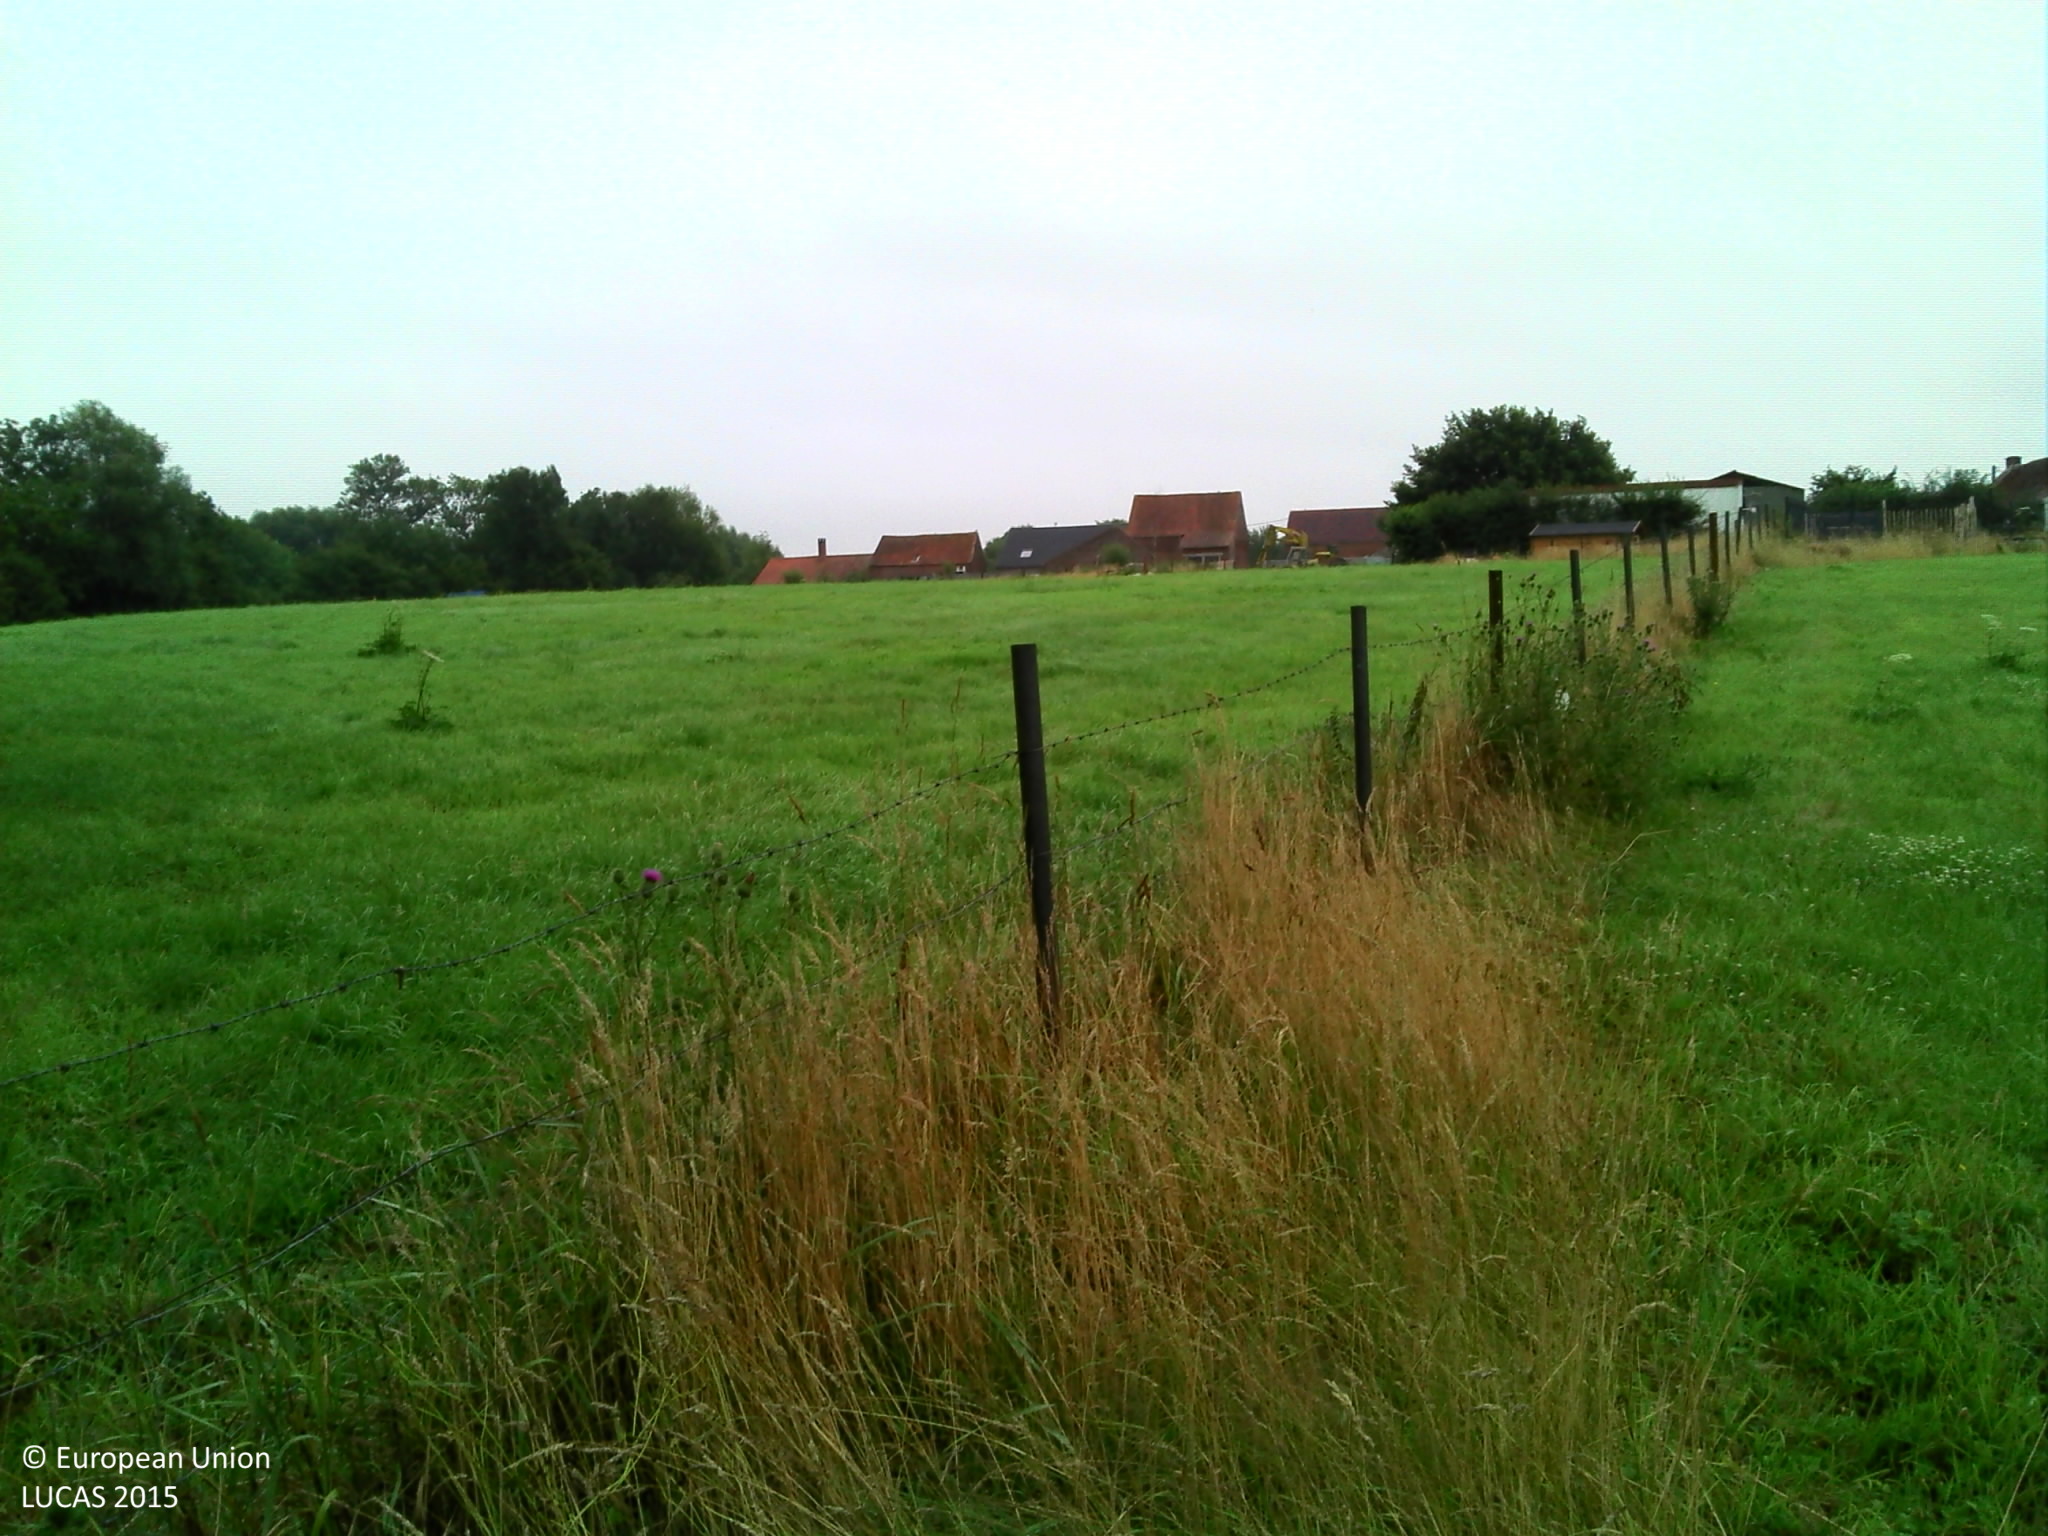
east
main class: Grassland
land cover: Grassland without tree/shrub cover
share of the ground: > 75 %
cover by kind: herbaceous plants 100 %
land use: Agriculture (excluding fallow land and kitchen gardens)
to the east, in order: Grassland without tree/shrub cover; Fences; Grassland without tree/shrub cover; Fences; Broadleaved woodland; Rivers and streams; Broadleaved woodland; Fences; Grassland without tree/shrub cover; Fences; Grassland without tree/shrub cover; Fences; Grassland without tree/shrub cover
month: July
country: BE
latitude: 50.5818
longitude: 3.9353
